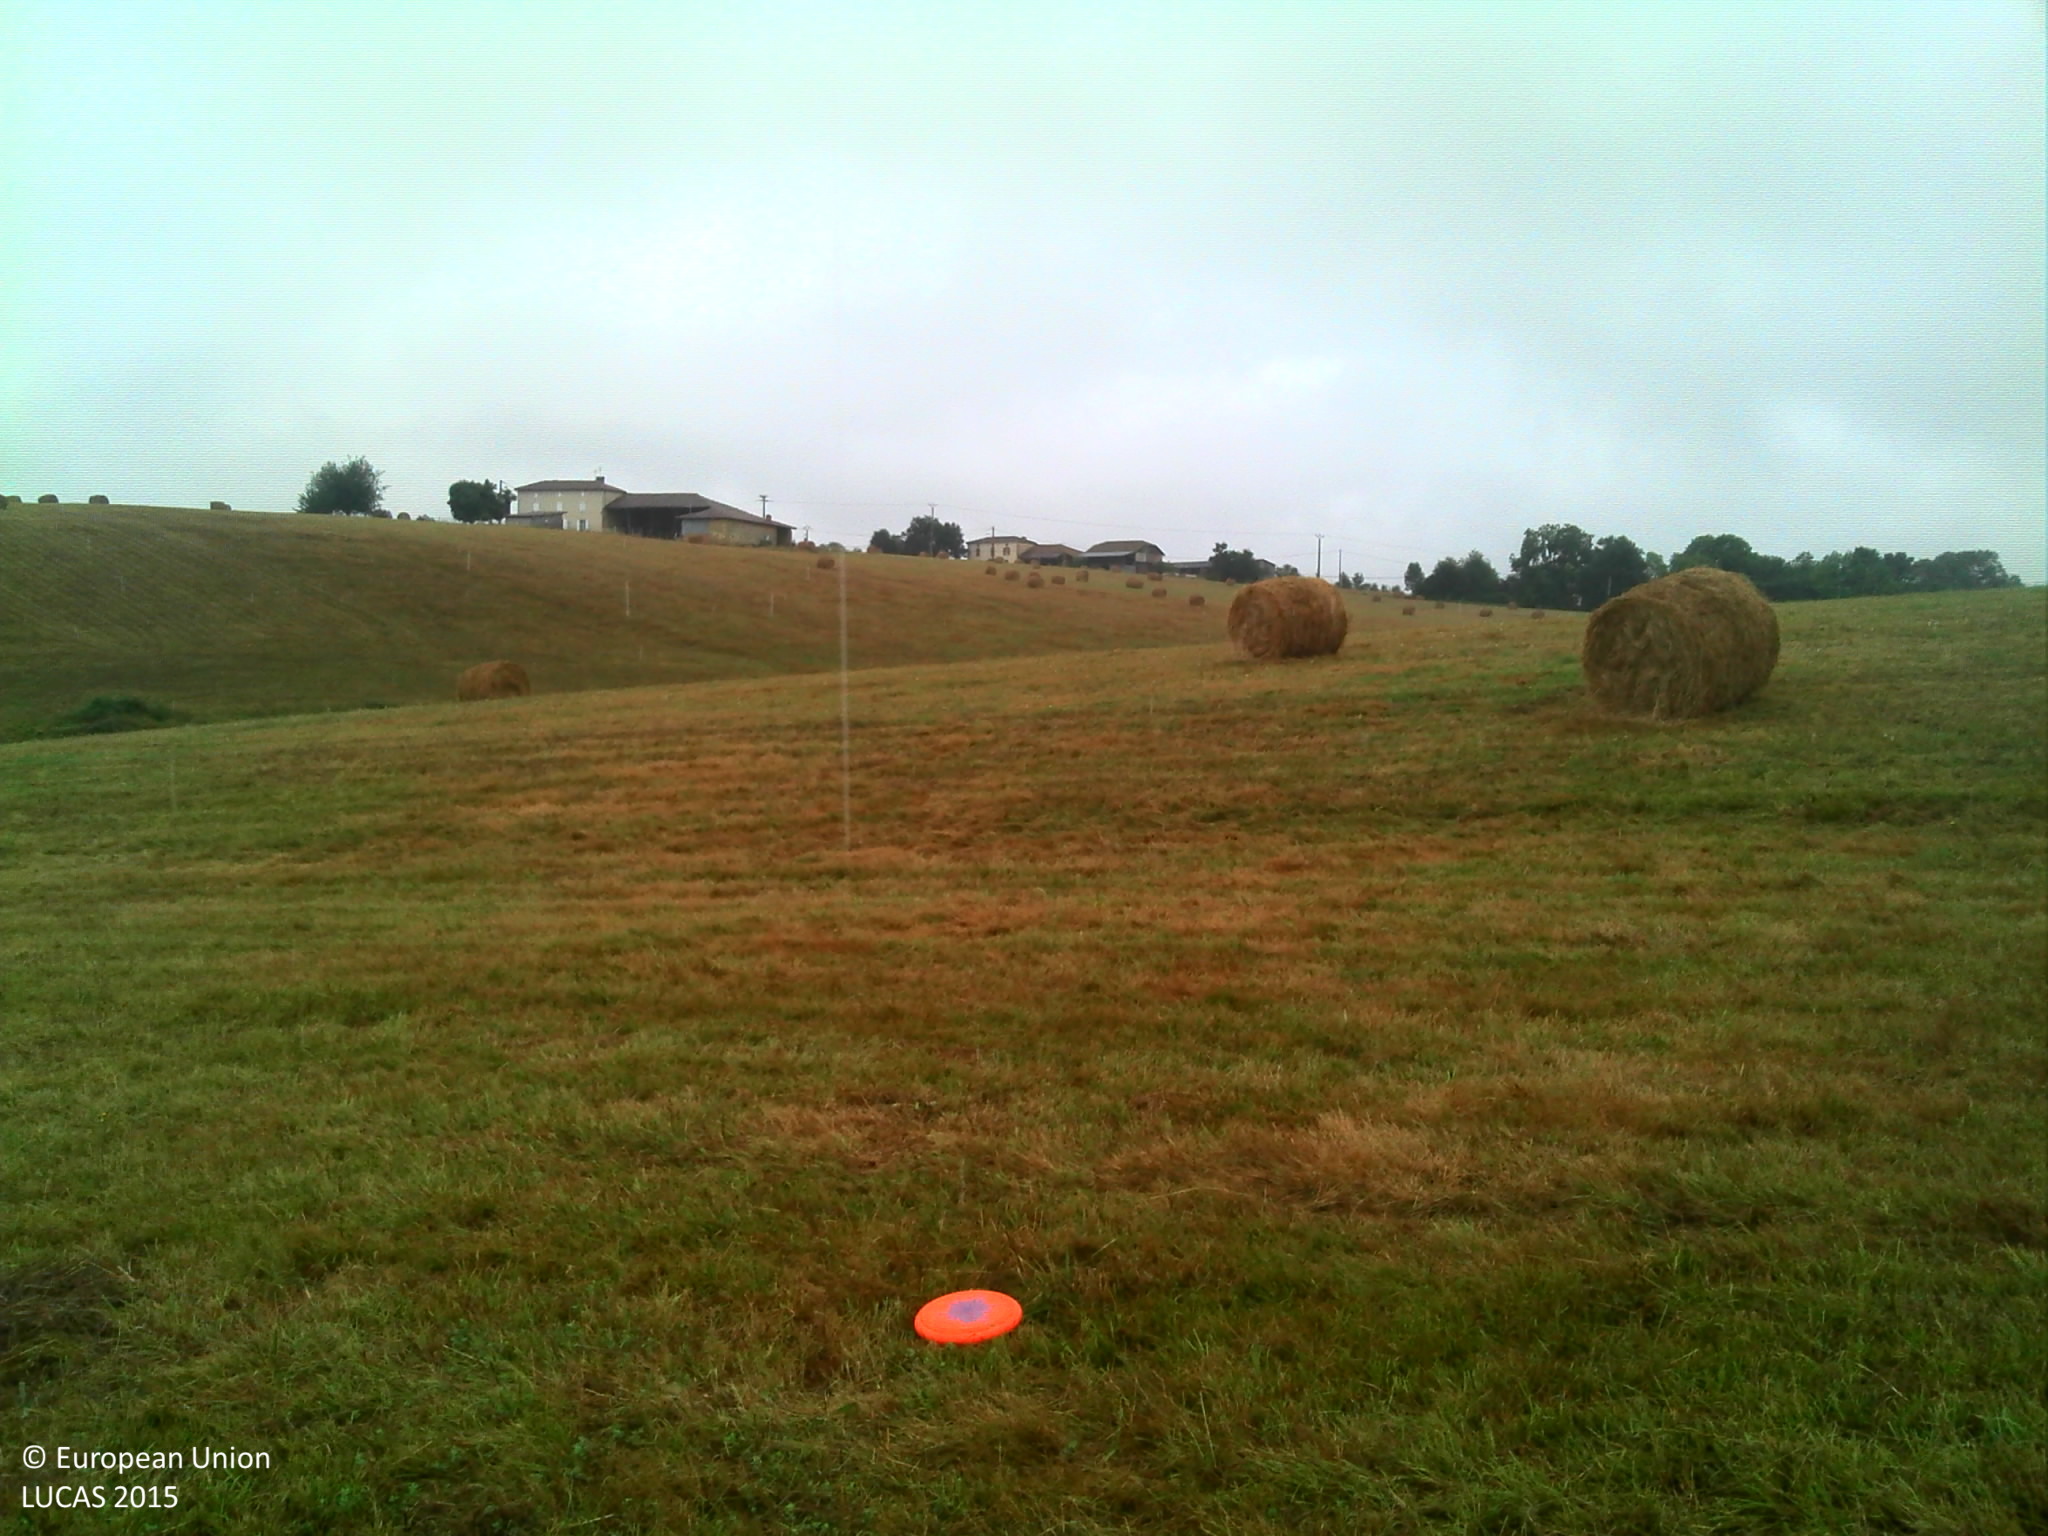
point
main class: Grassland
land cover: Grassland without tree/shrub cover
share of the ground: > 75 %
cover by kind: herbaceous plants 100 %
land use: Agriculture (excluding fallow land and kitchen gardens)
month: July
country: FR
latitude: 43.2336
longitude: 0.8033
